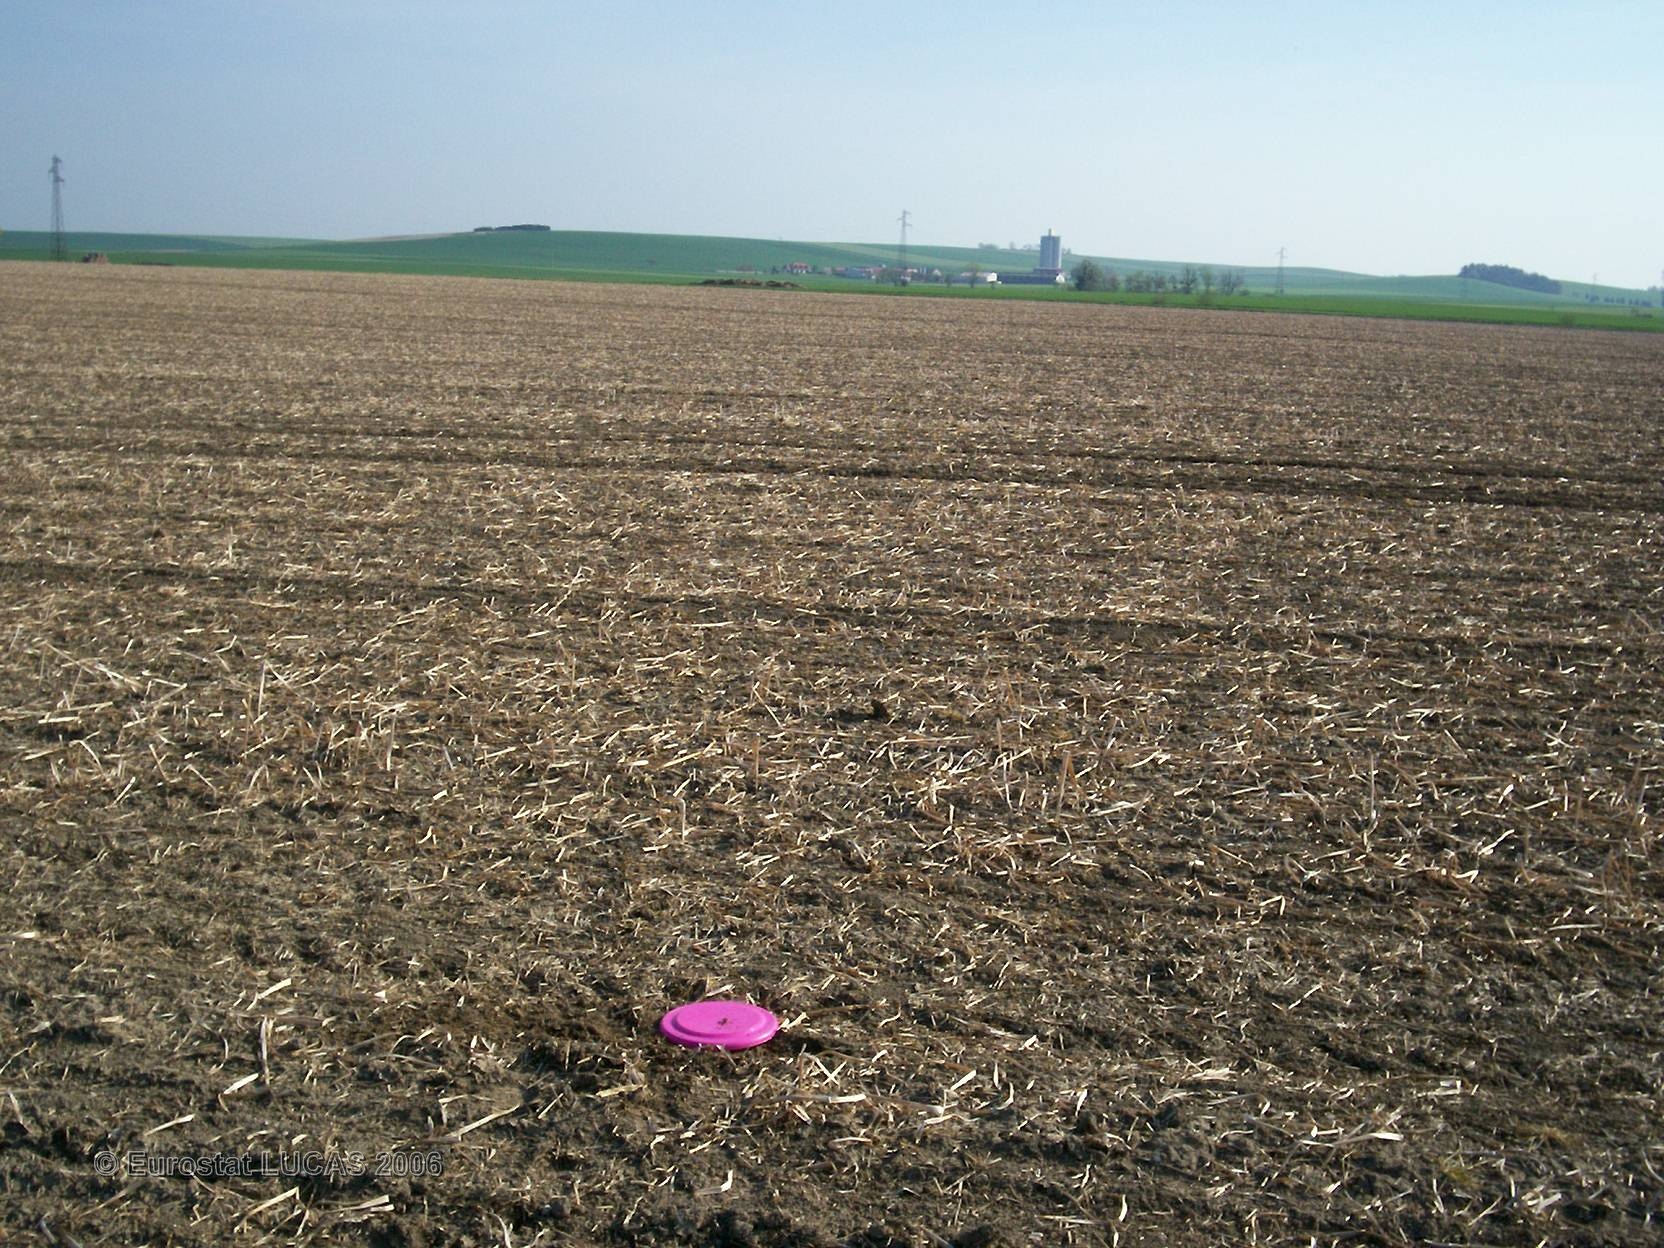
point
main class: Cropland
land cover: Sugar beet
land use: Agriculture (excluding fallow land and kitchen gardens)
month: April
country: FR
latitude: 48.4660
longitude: 4.5198
